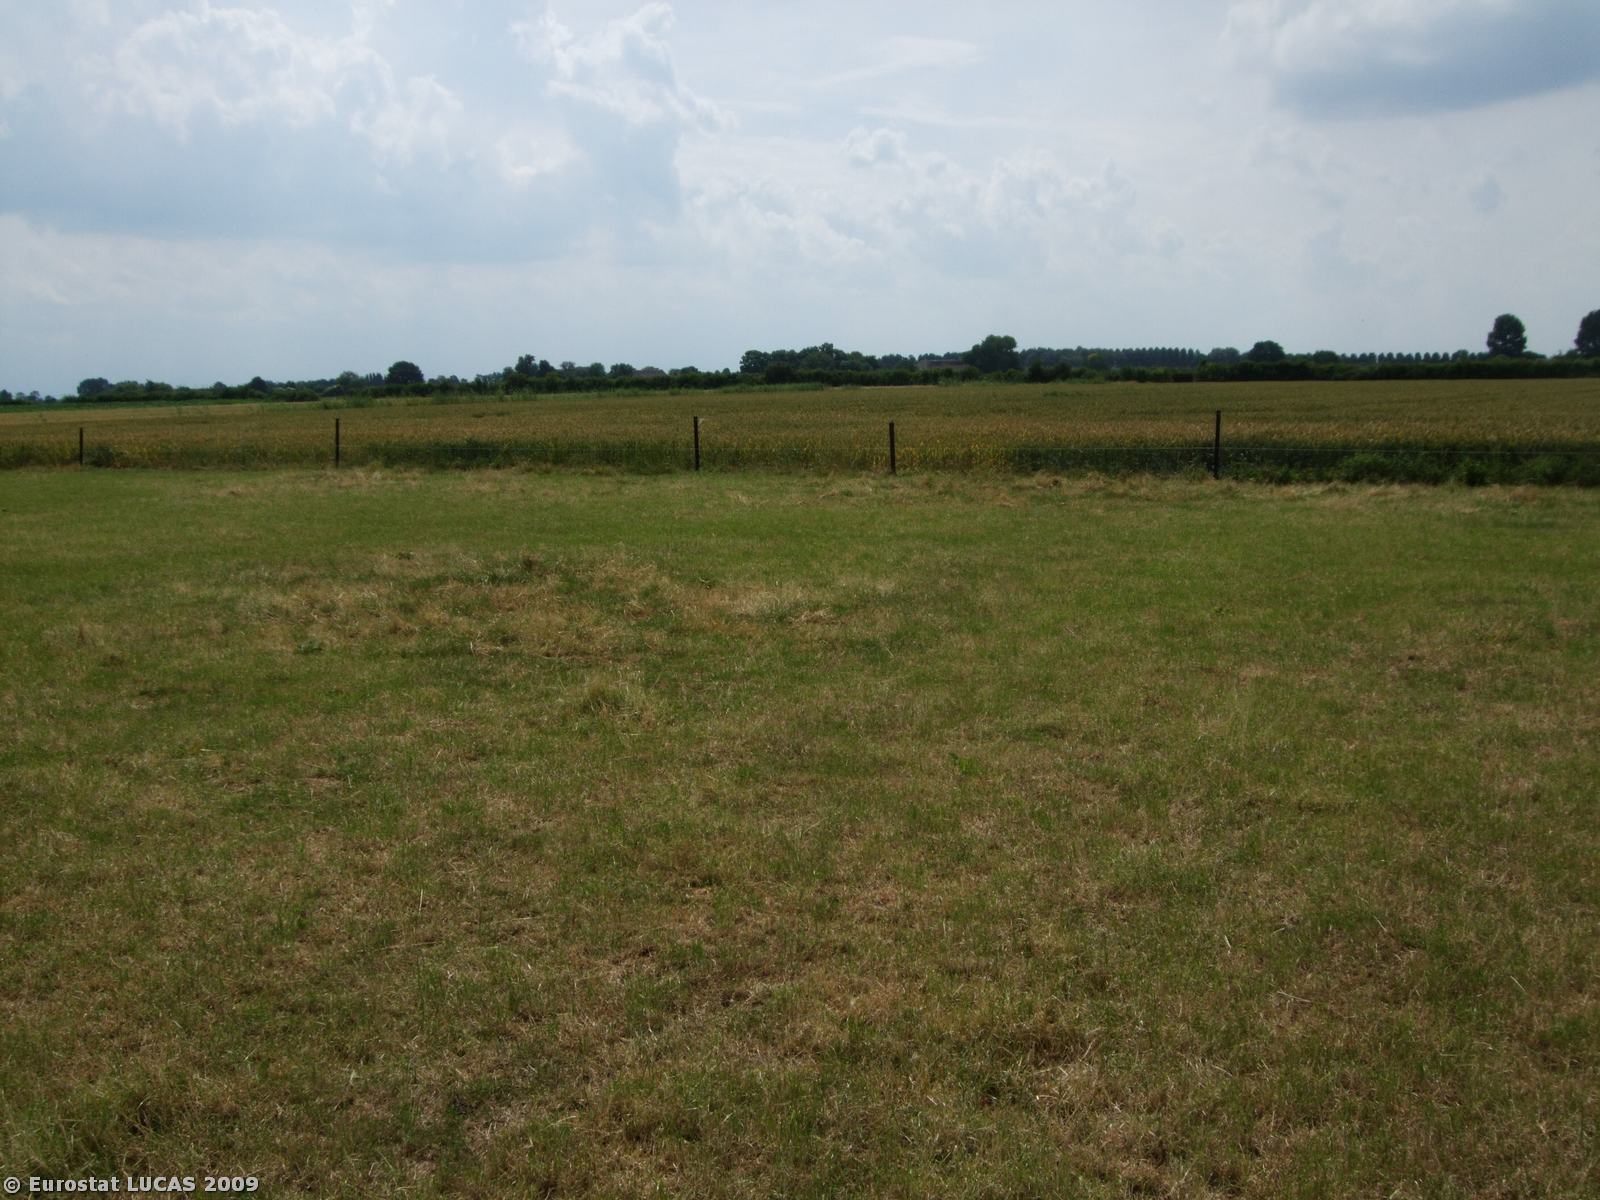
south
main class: Grassland
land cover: Grassland without tree/shrub cover
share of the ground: > 75 %
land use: Agriculture (excluding fallow land and kitchen gardens)
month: July
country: NL
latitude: 51.8897
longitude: 5.3338
